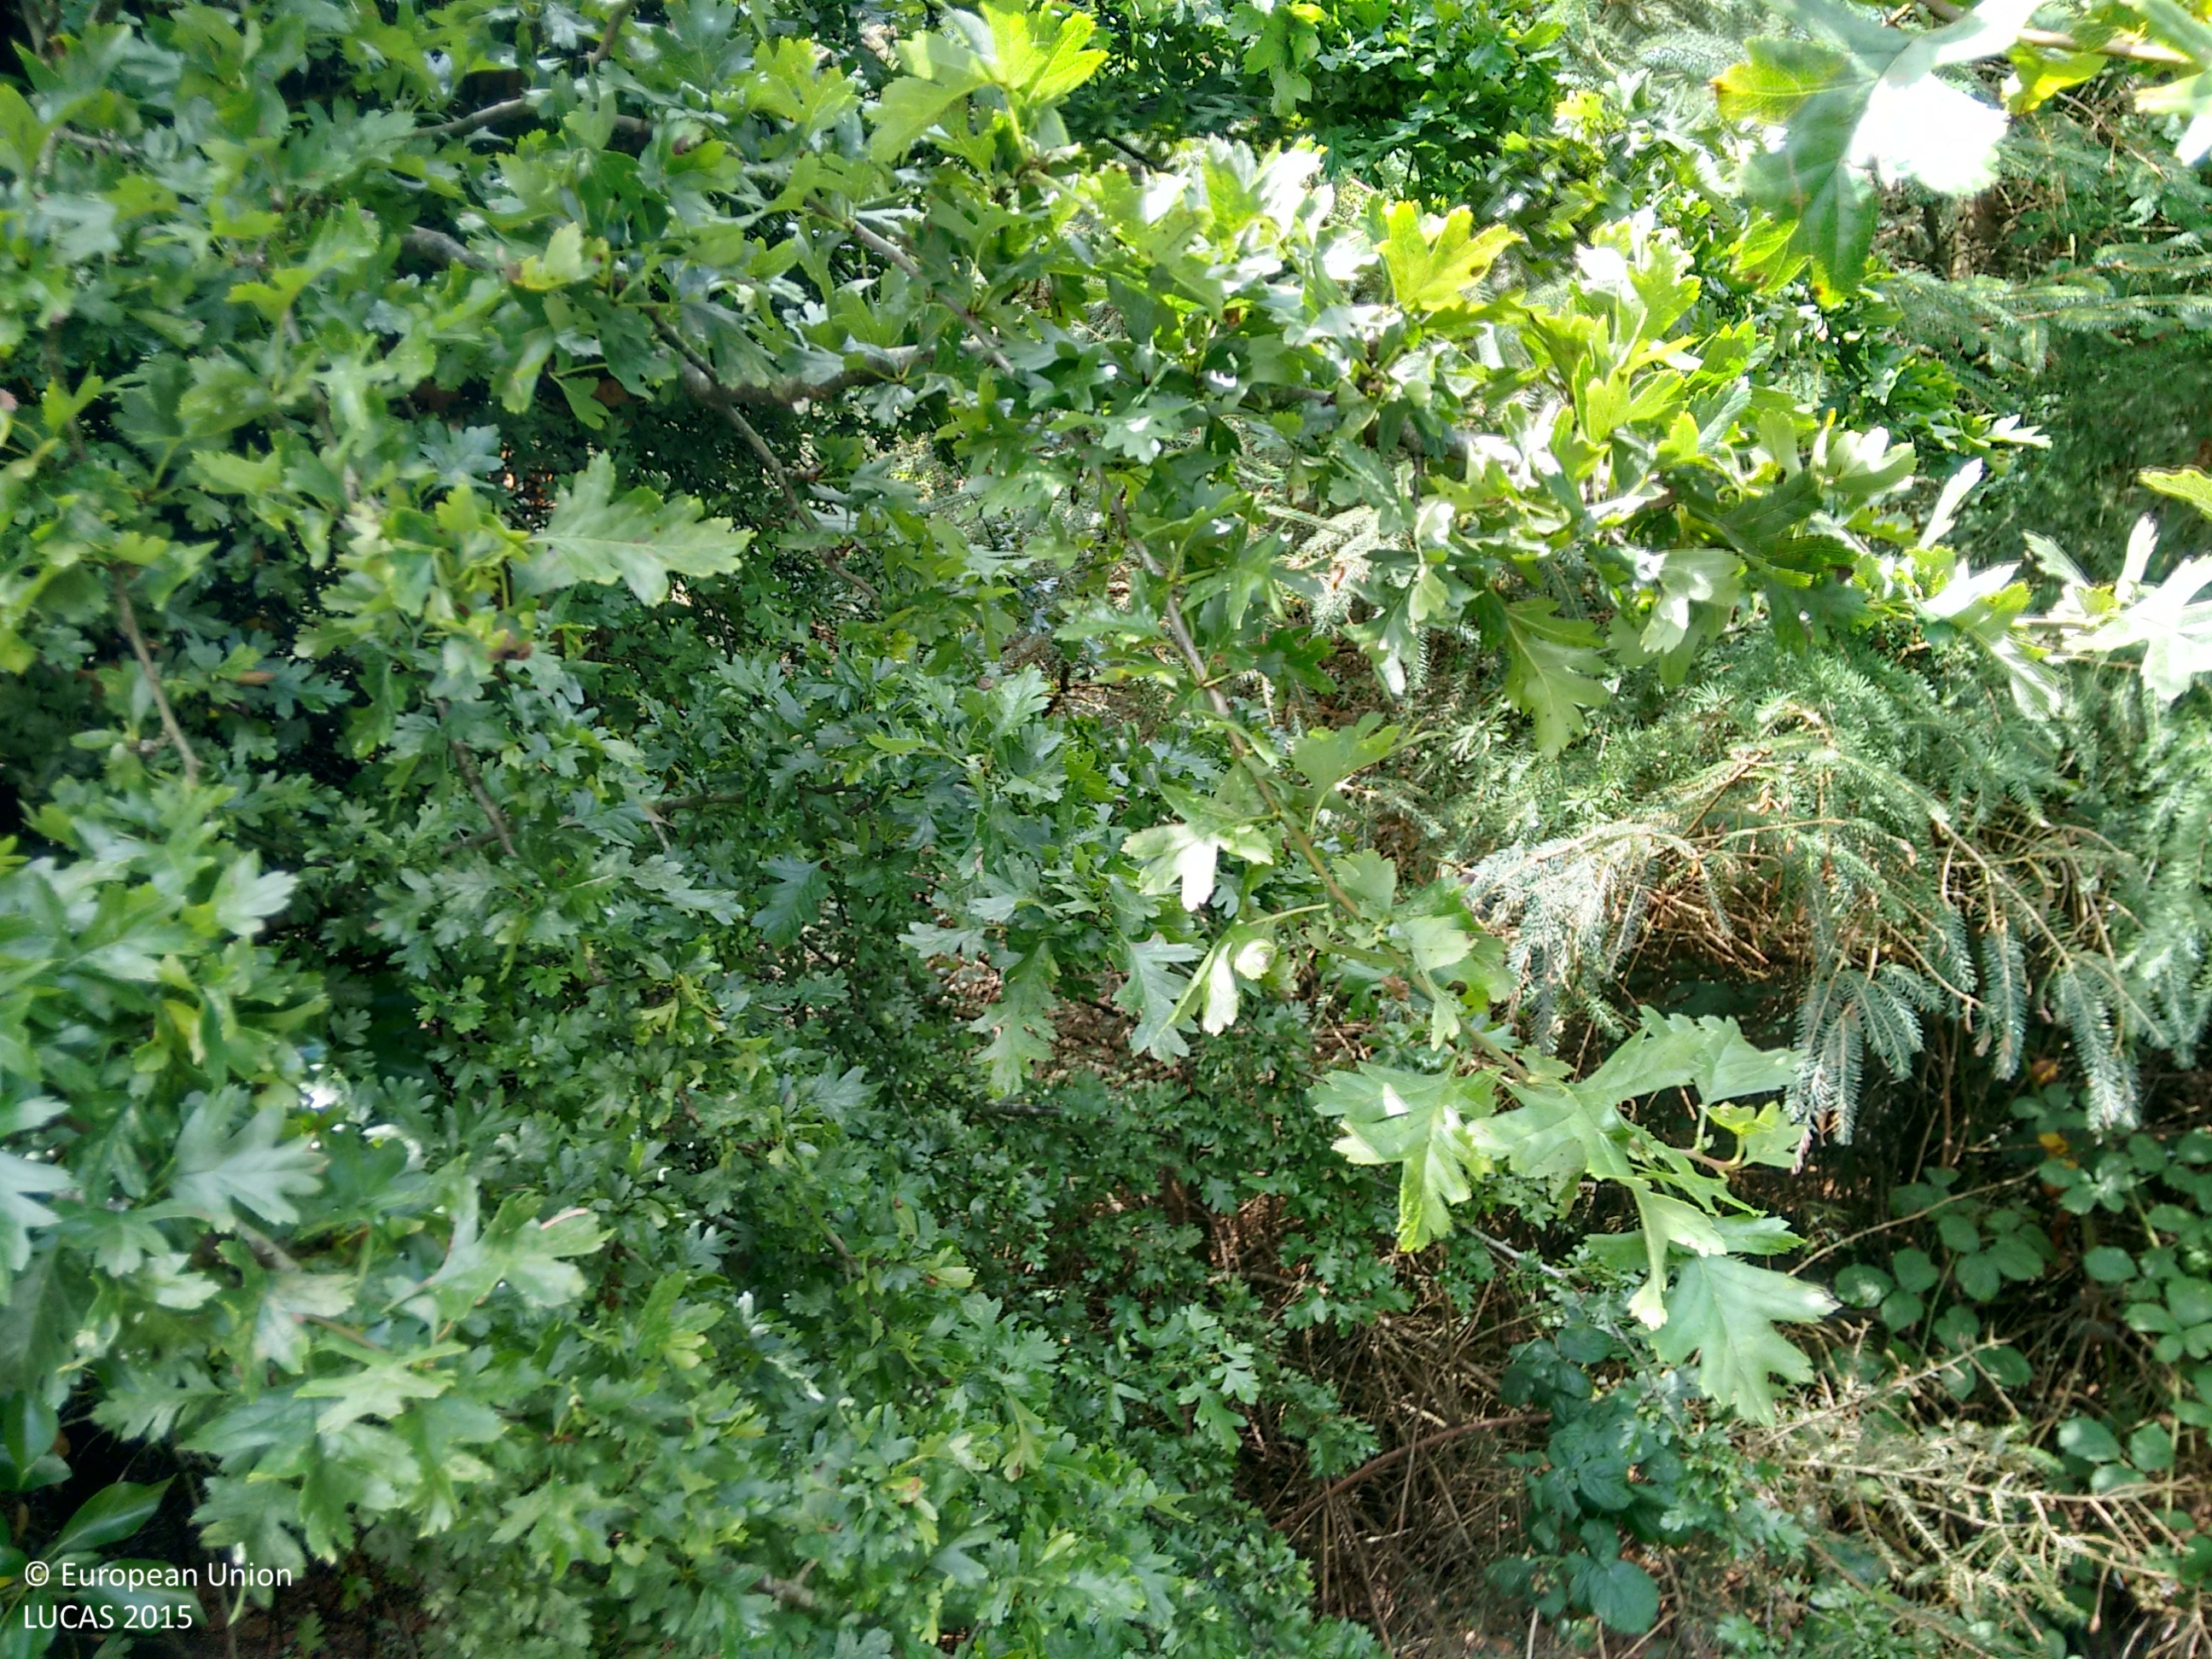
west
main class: Woodland
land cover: Spruce dominated mixed woodland
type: exotic forest
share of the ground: > 75 %
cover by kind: coniferous forest trees 75 %, broadleaved forest trees 25 %
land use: Forestry
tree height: > 5 m
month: August
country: IE
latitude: 52.6432
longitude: -6.2441
